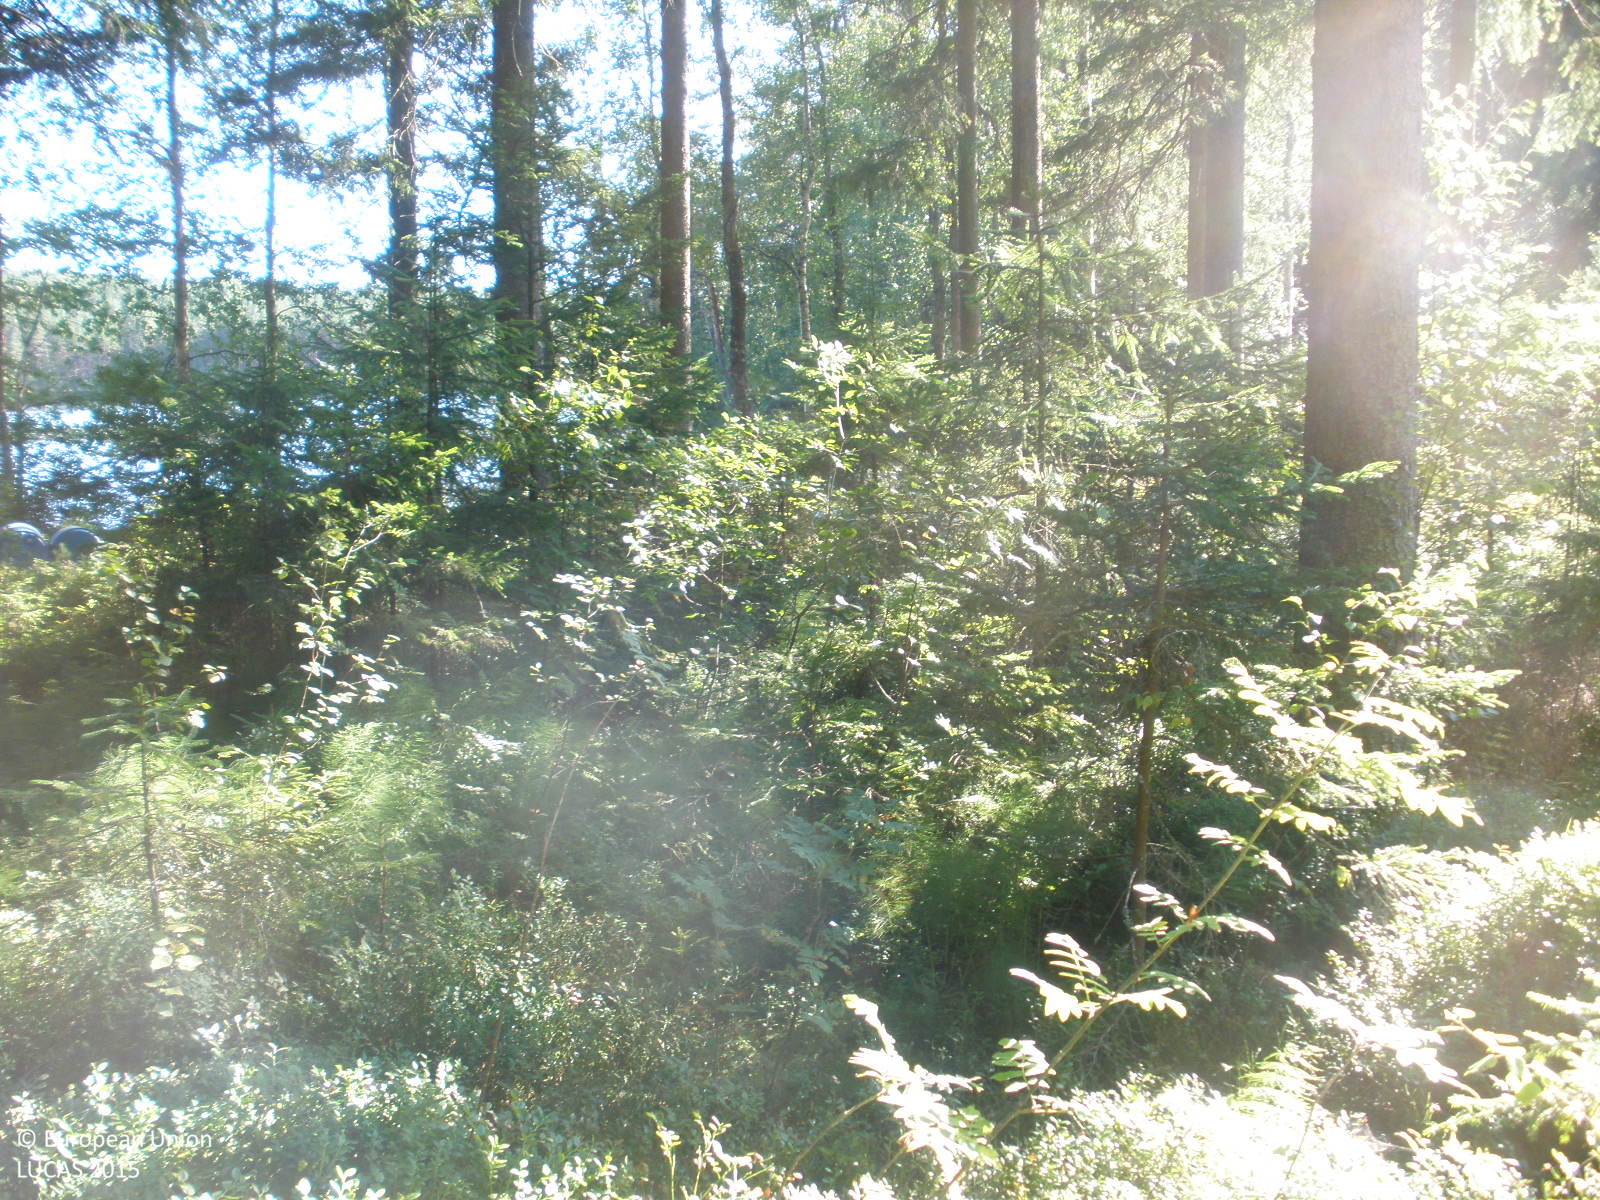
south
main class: Woodland
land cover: Spruce dominated coniferous woodland
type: boreal forest
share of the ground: > 75 %
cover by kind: coniferous forest trees 75 %, herbaceous plants 15 %, shrubs 5 %, lichens and mosses 5 %
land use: Forestry
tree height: > 5 m
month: August
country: FI
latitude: 60.5650
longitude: 23.9402
